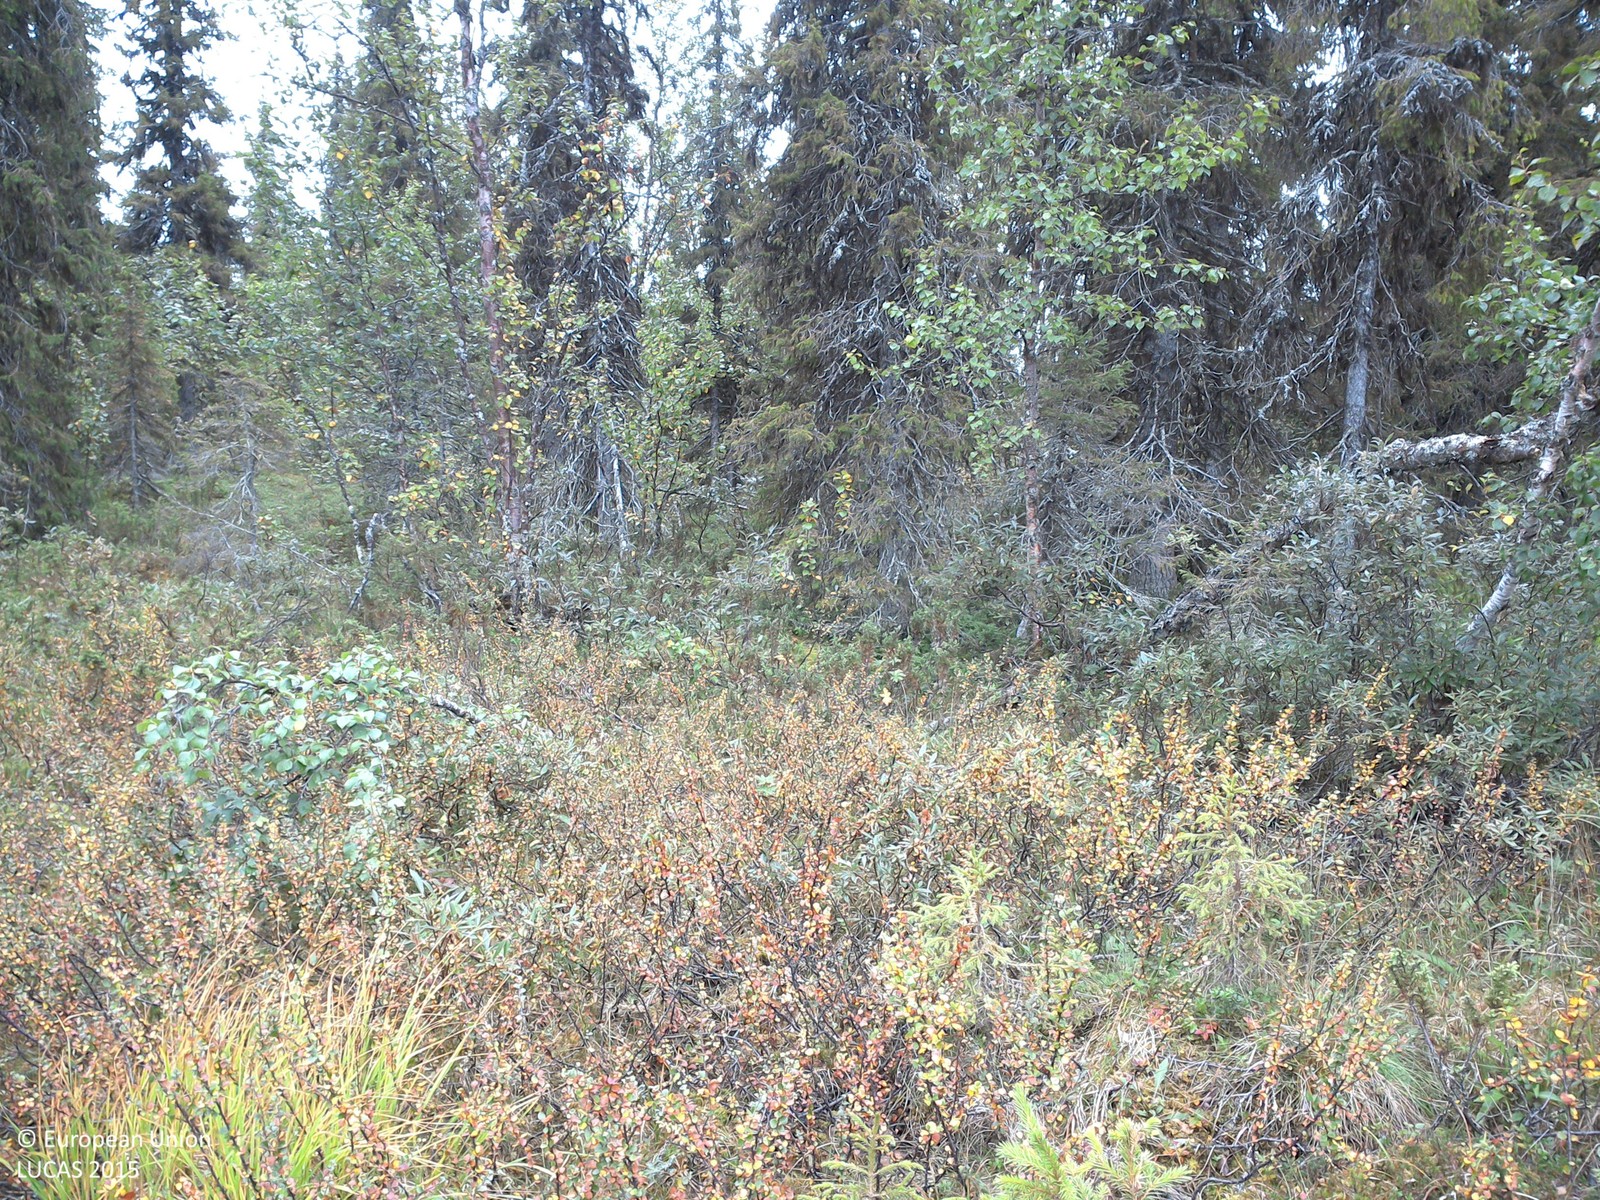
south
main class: Woodland
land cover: Spruce dominated mixed woodland
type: boreal forest
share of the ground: 25 - 50 %
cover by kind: shrubs 45 %, coniferous forest trees 20 %, herbaceous plants 20 %, broadleaved forest trees 10 %, lichens and mosses 5 %
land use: Amenities, museums, leisure
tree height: > 5 m
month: August
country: SE
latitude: 67.8769
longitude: 21.5805
